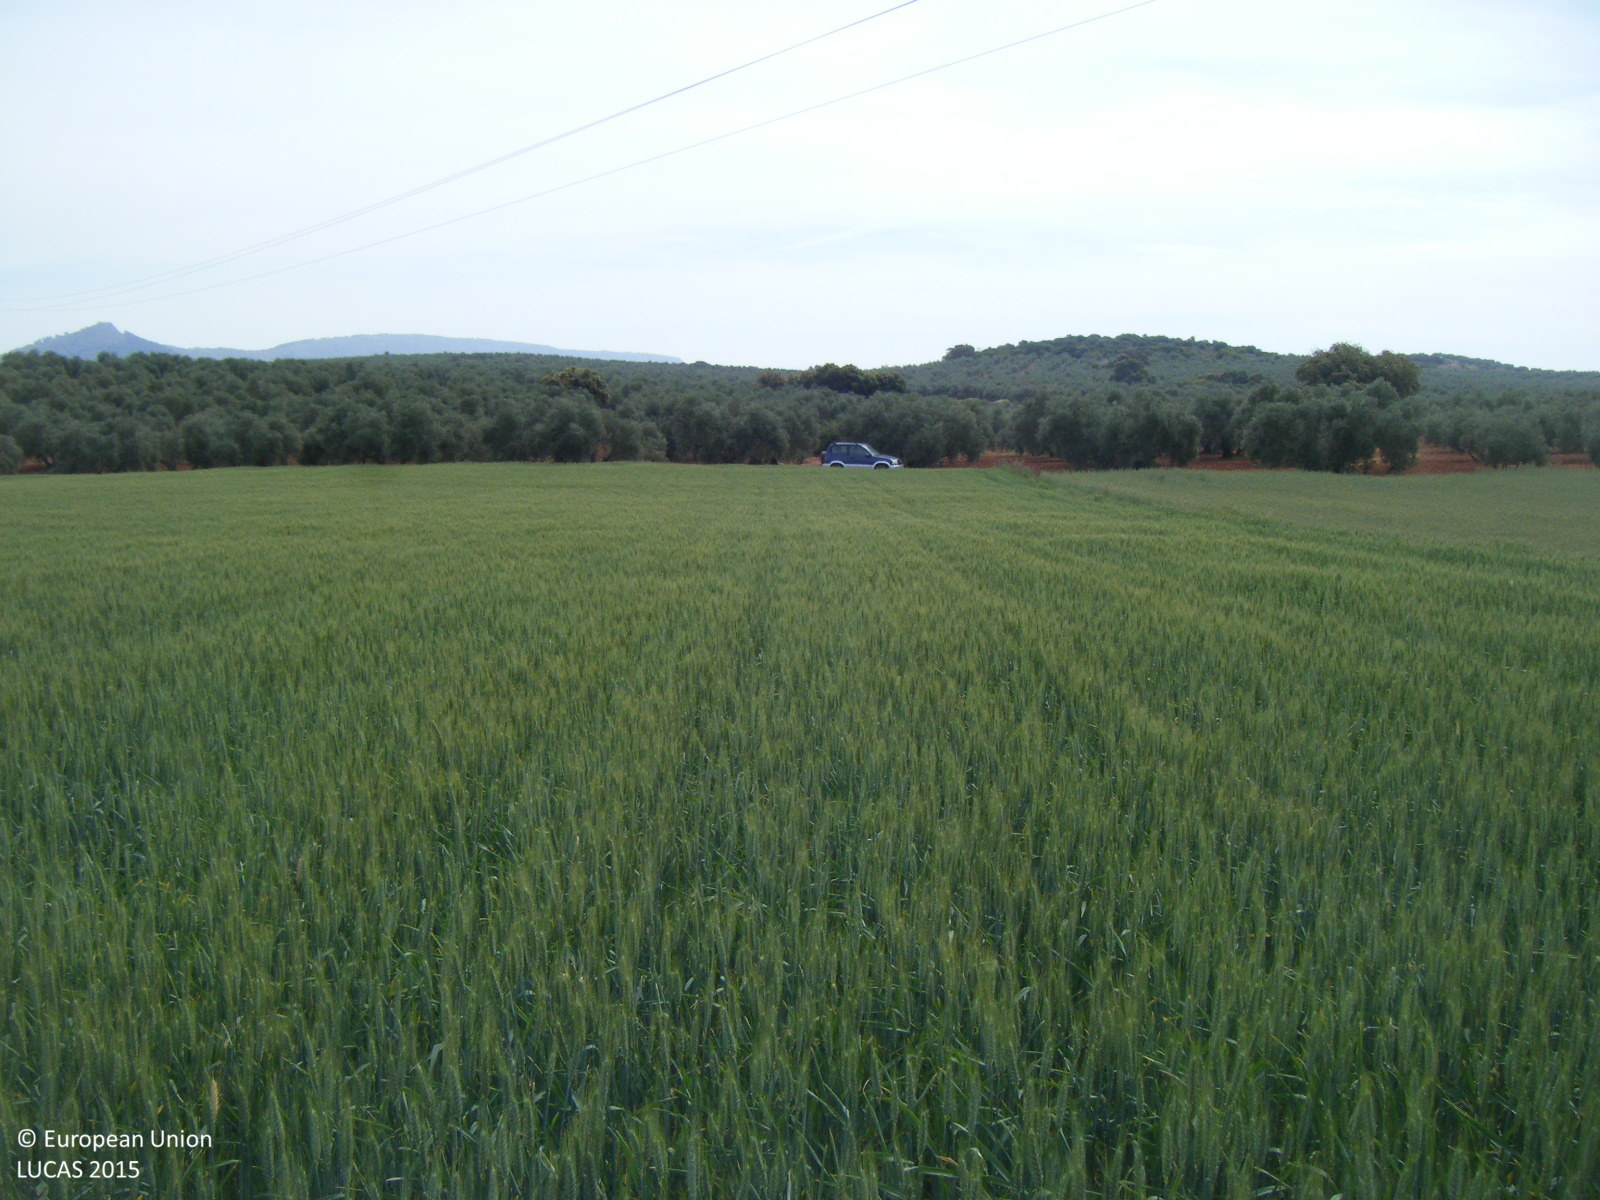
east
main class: Cropland
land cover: Durum wheat
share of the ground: > 75 %
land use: Agriculture (excluding fallow land and kitchen gardens)
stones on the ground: < 10 %
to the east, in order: Durum wheat; Electric lines; Durum wheat; Olive groves; Shrubland without tree cover; Other bare soil
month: April
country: ES
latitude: 37.0840
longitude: -4.7709
